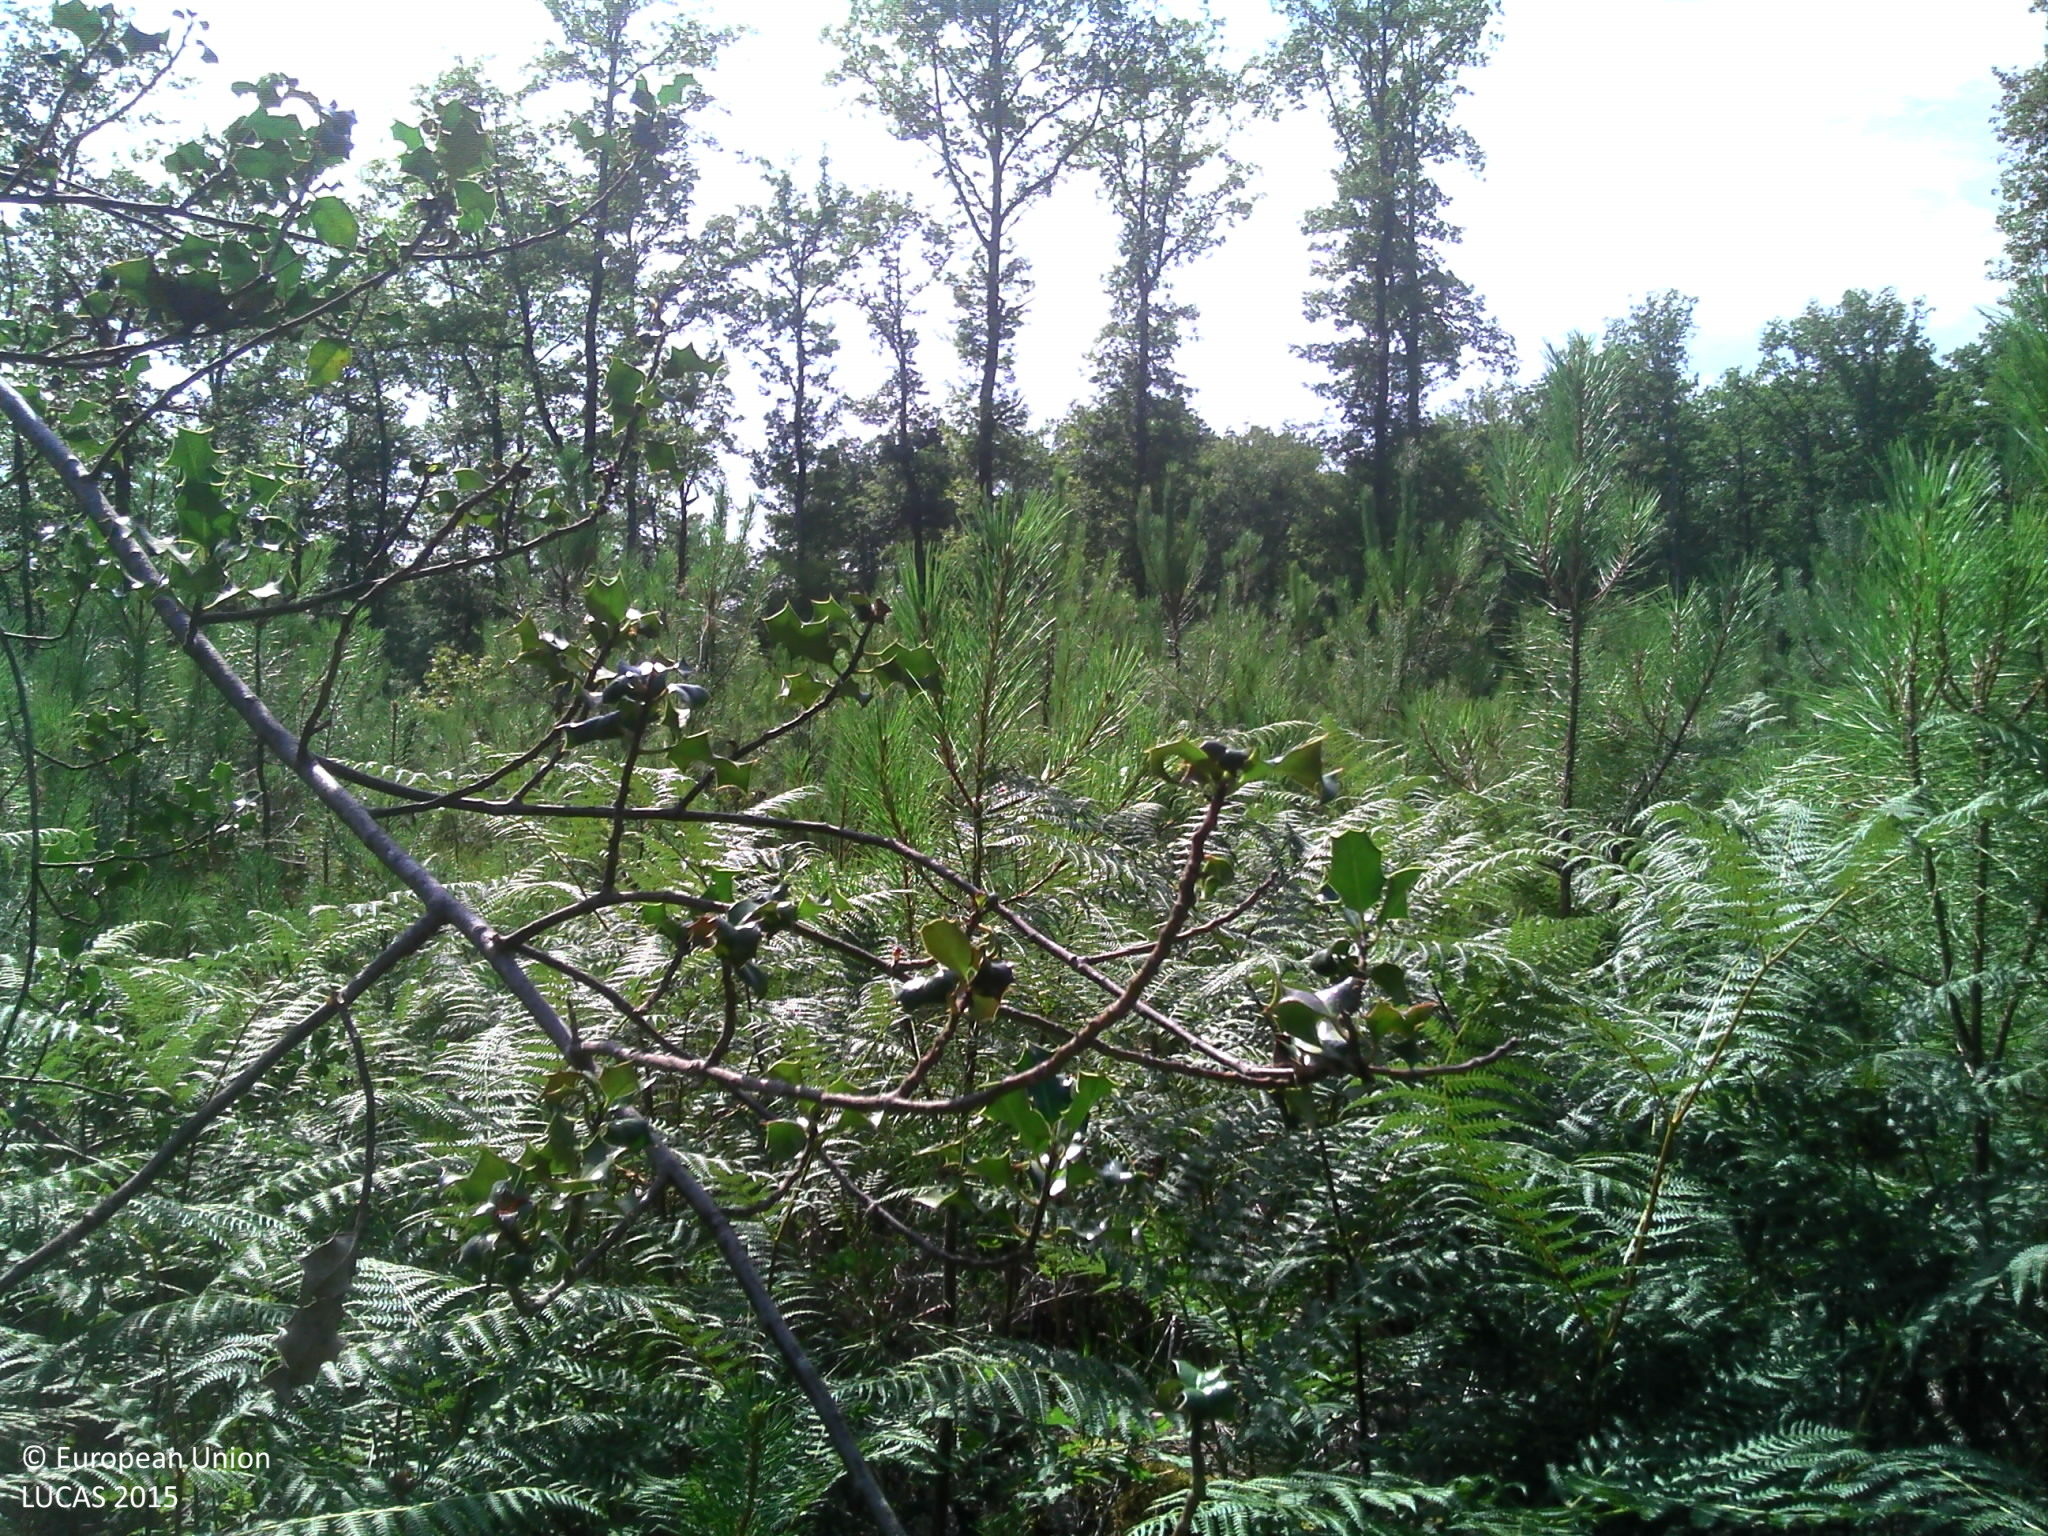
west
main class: Woodland
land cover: Pine dominated mixed woodland
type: exotic forest
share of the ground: > 75 %
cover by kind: coniferous forest trees 40 %, broadleaved forest trees 25 %, shrubs 20 %, herbaceous plants 10 %, lichens and mosses 5 %
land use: Forestry
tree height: < 5 m
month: July
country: FR
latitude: 47.2396
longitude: 0.3747
